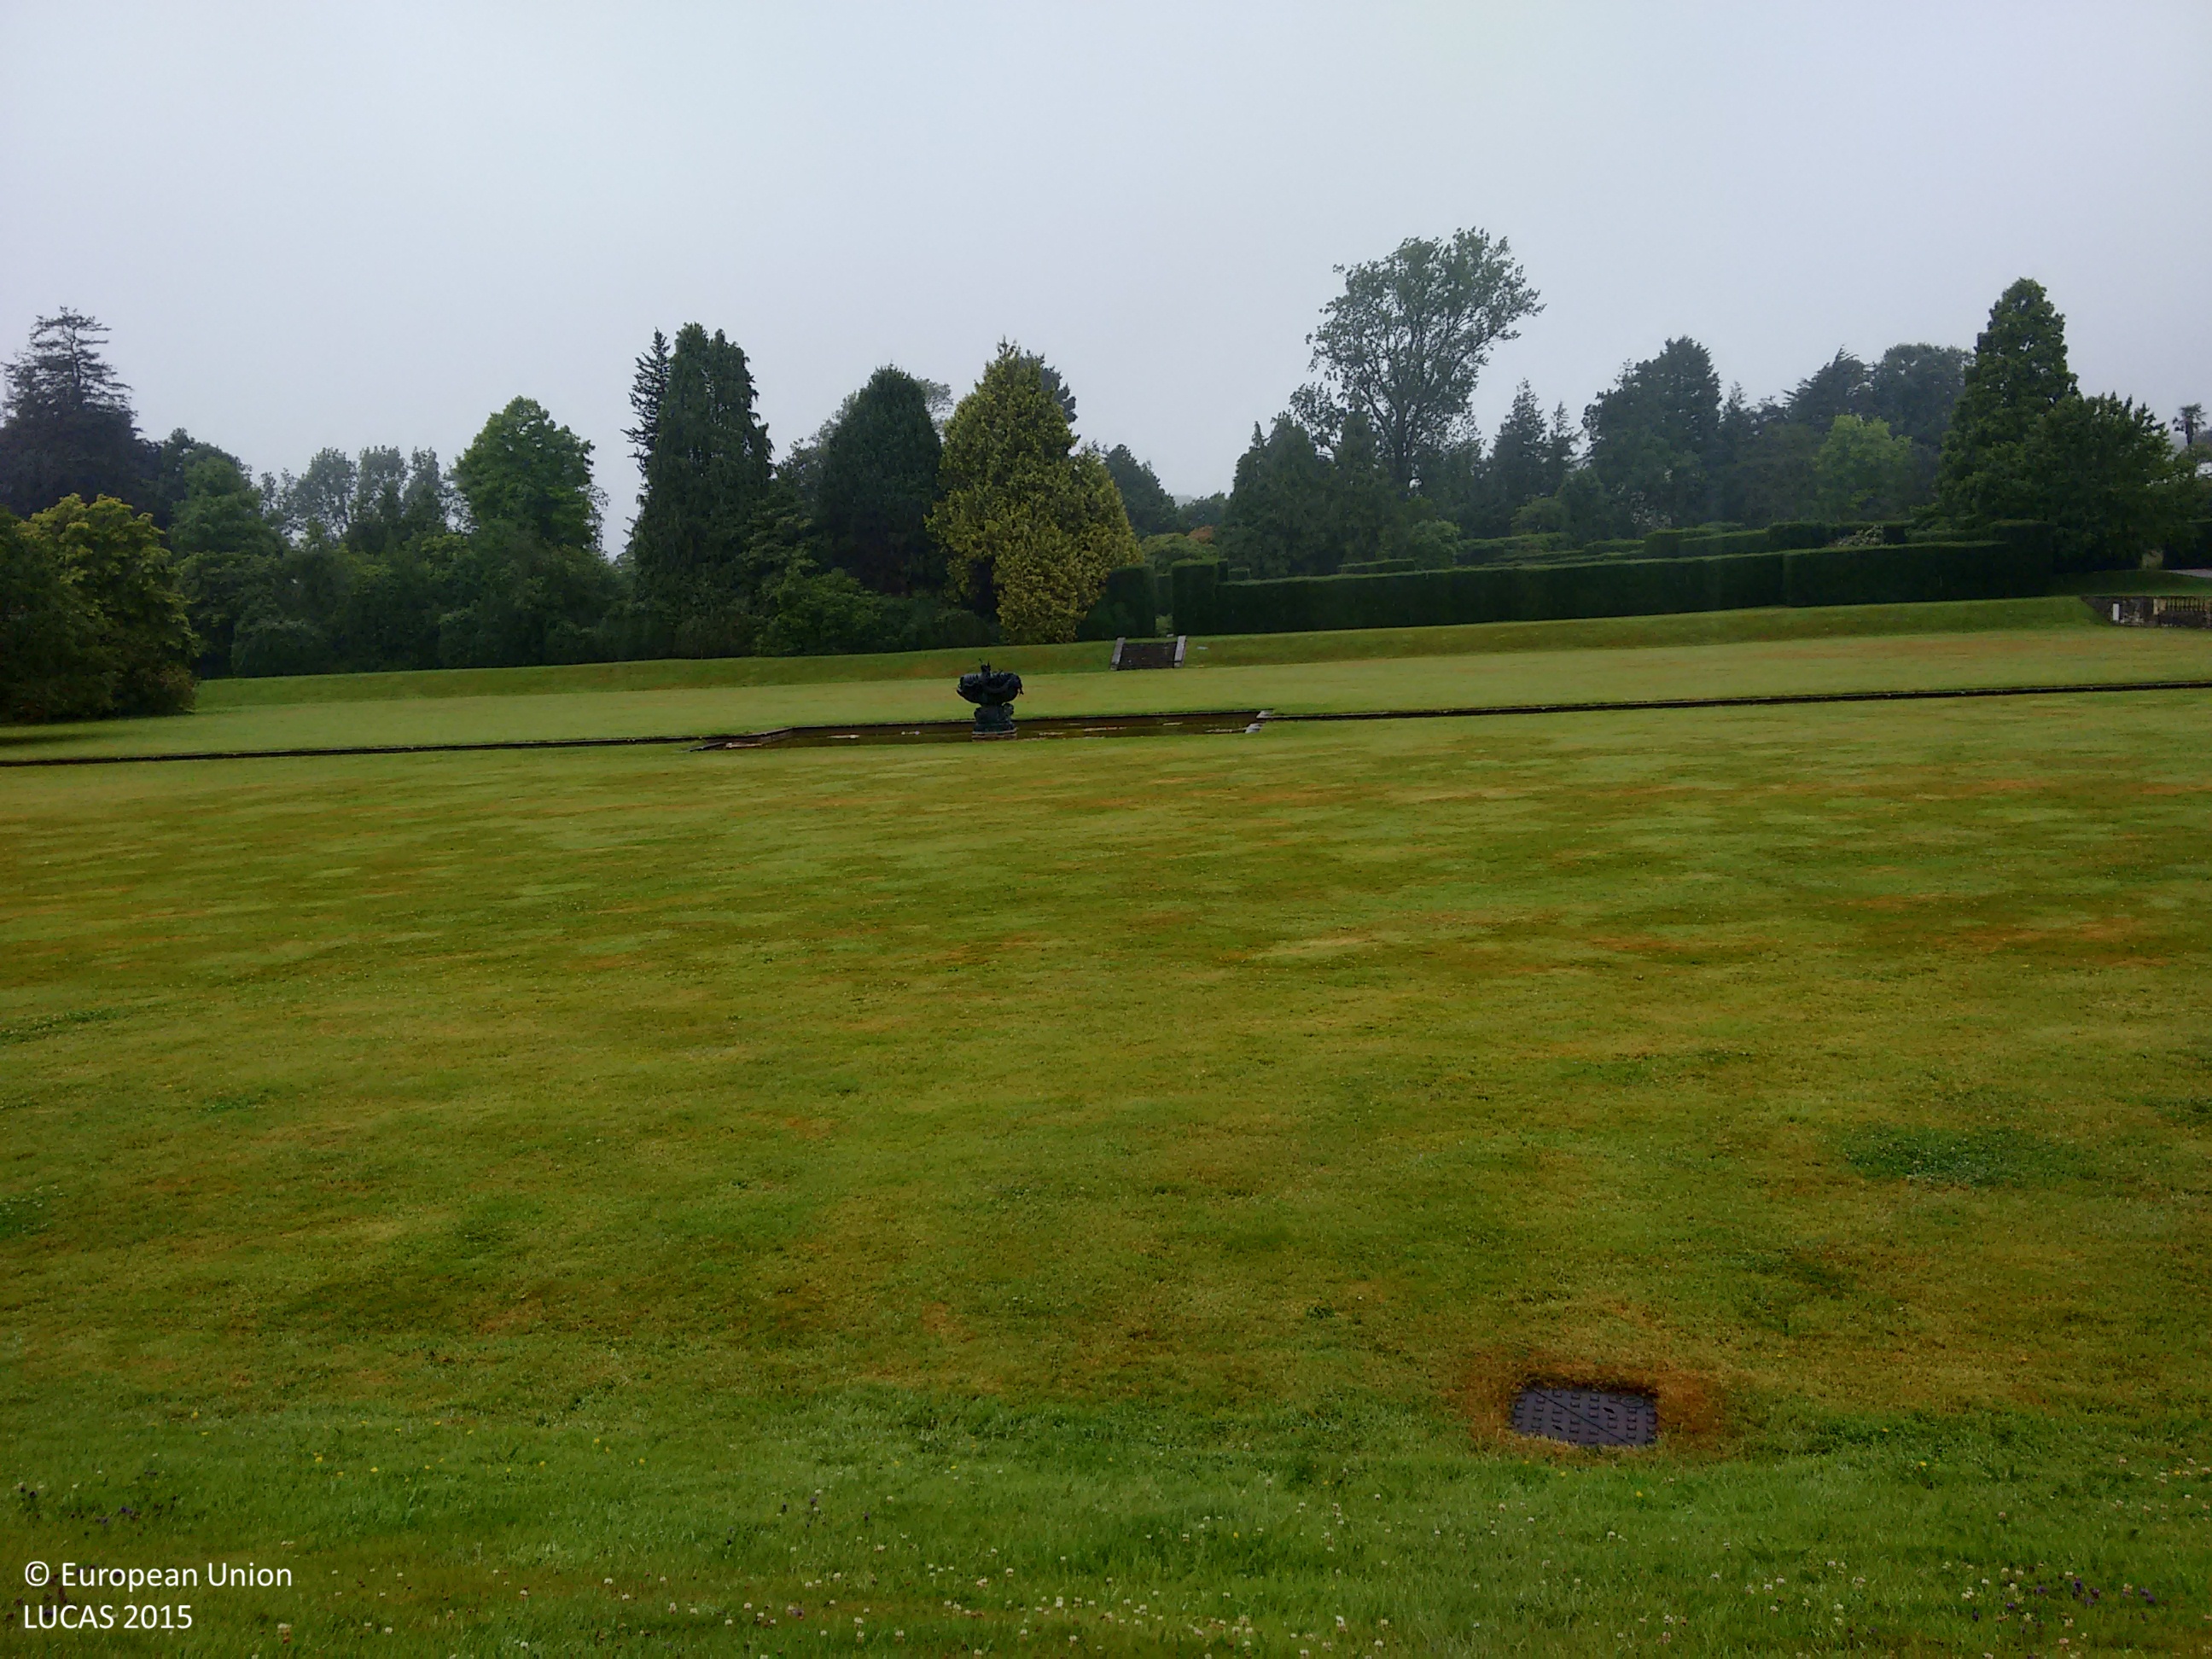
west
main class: Grassland
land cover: Grassland without tree/shrub cover
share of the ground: > 75 %
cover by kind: herbaceous plants 100 %
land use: Amenities, museums, leisure
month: July
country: GB
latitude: 51.4421
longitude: -3.3025
